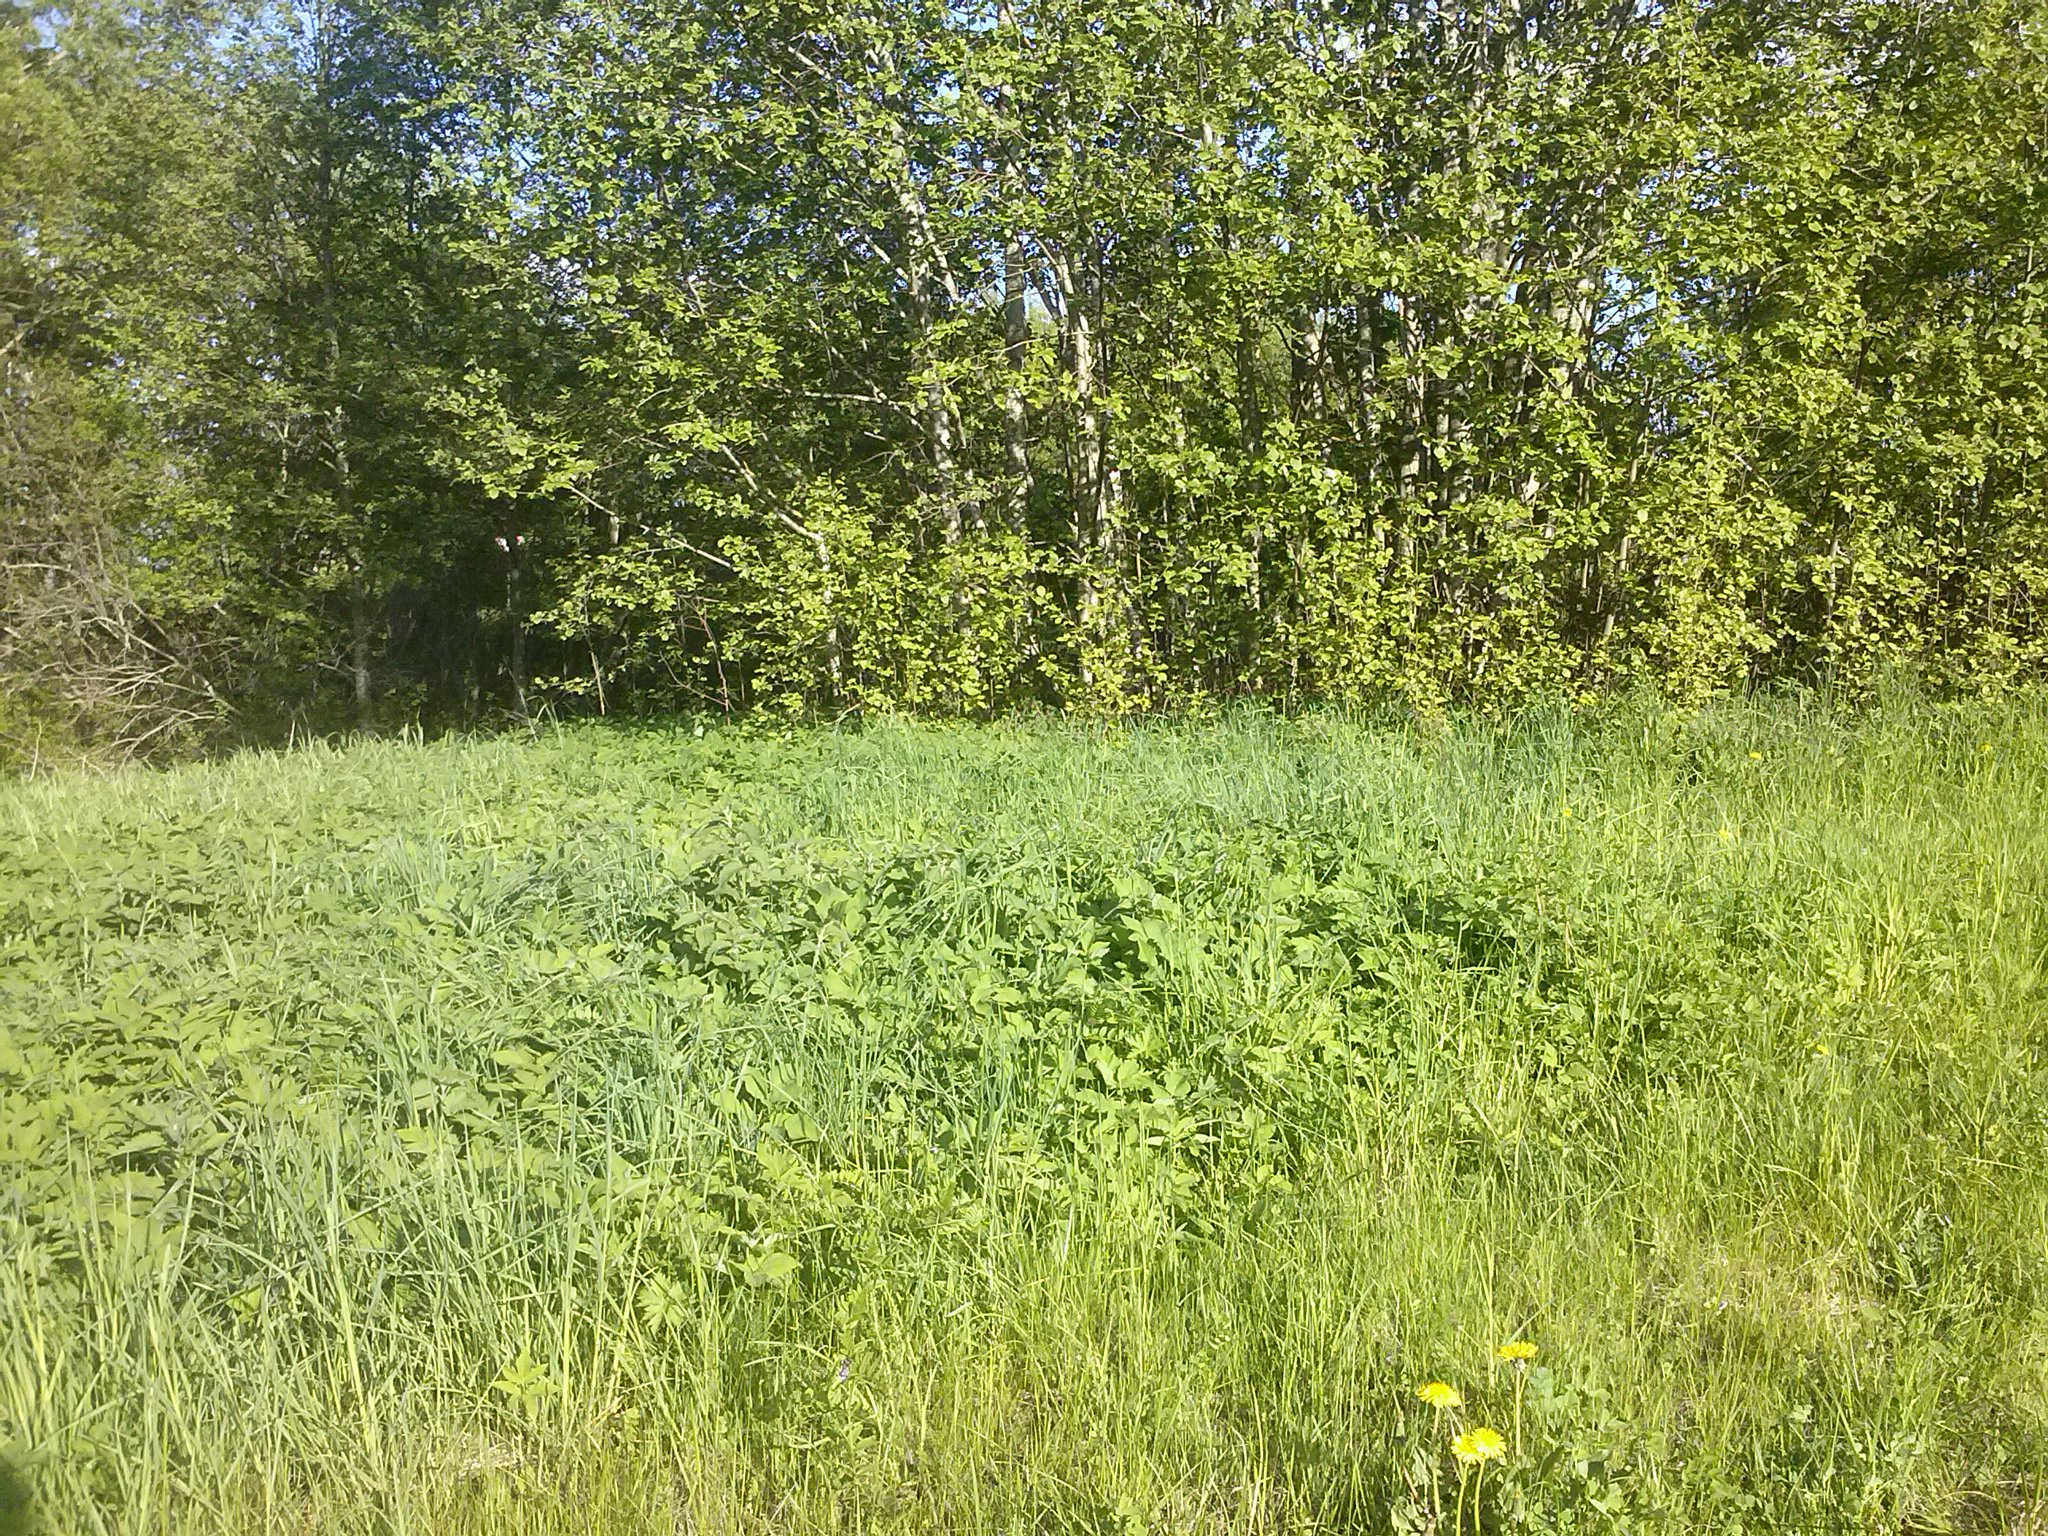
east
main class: Grassland
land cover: Grassland without tree/shrub cover
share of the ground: > 75 %
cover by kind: herbaceous plants 100 %
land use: Abandoned areas
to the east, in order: Grassland without tree/shrub cover; Broadleaved woodland; Paved roads, cycling and walking lanes; Grassland with sparse tree/shrub cover; Electric lines; Broadleaved woodland; Inland fresh water bodies
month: May
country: LV
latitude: 56.2880
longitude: 27.4485
